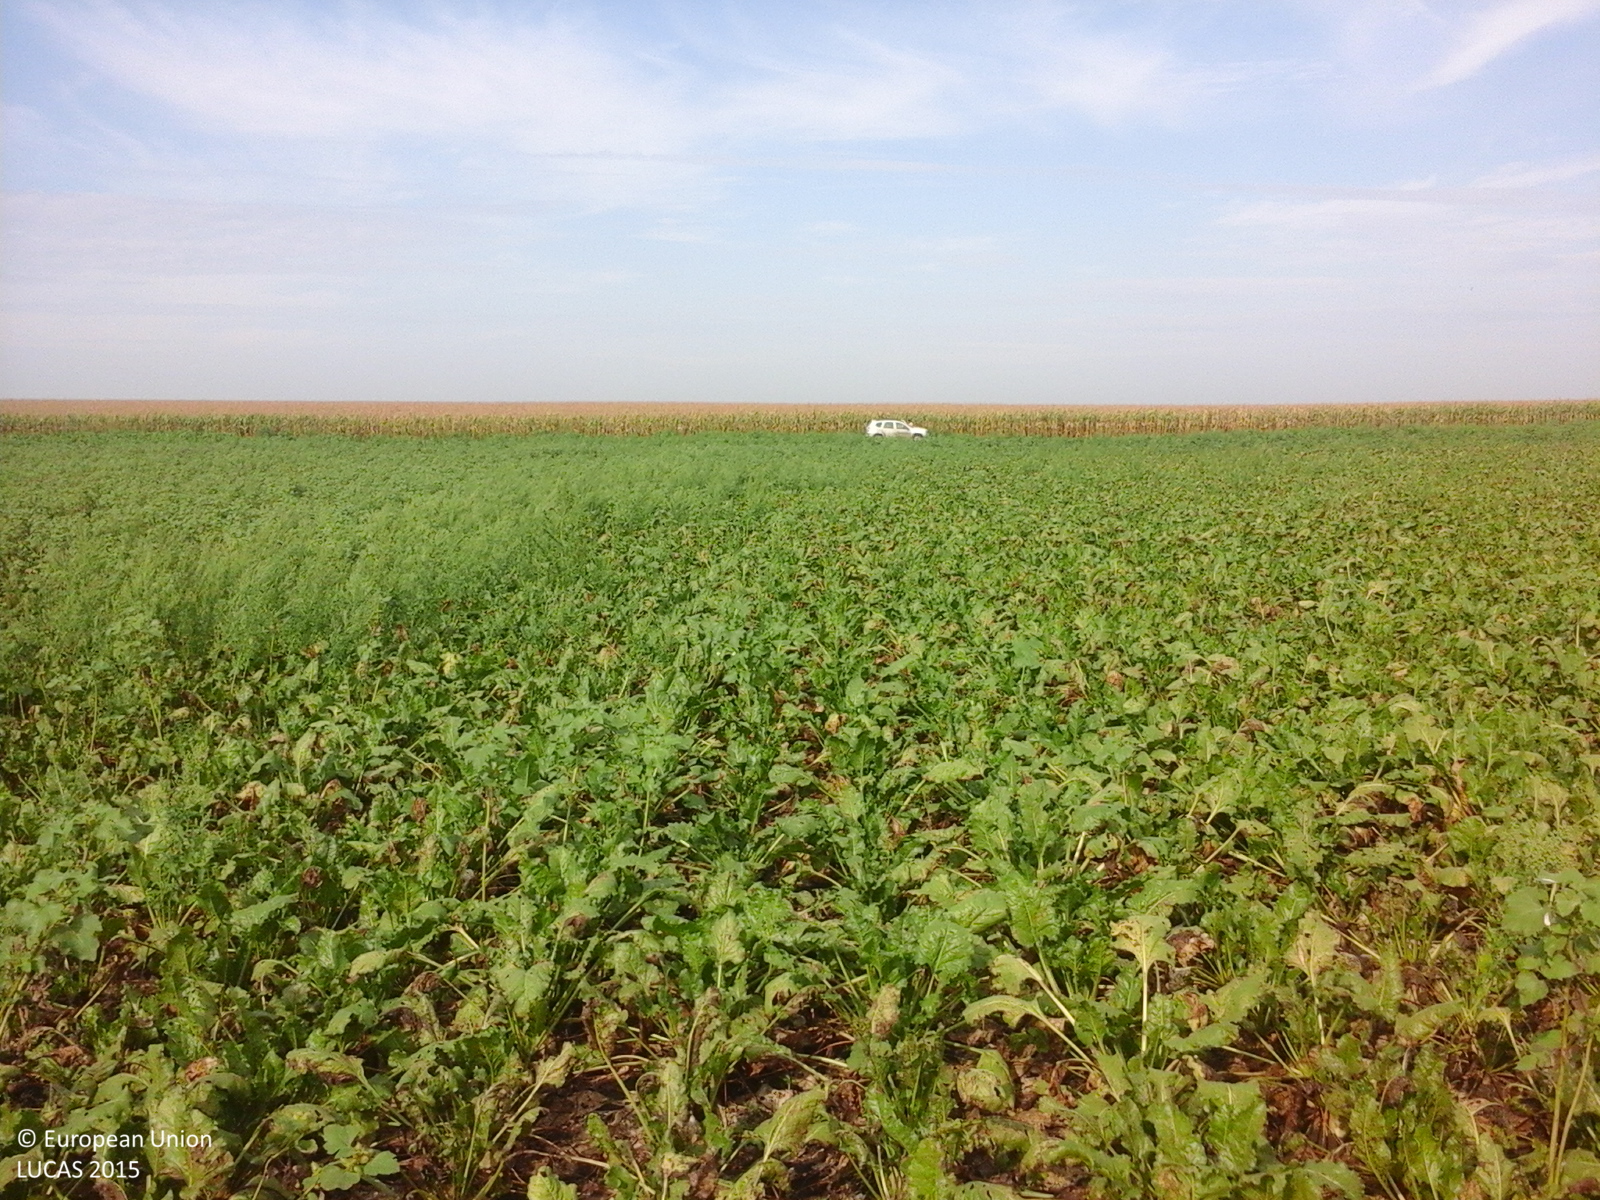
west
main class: Cropland
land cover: Sugar beet
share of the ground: > 75 %
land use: Agriculture (excluding fallow land and kitchen gardens)
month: August
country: RO
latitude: 46.1769
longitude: 20.8712
